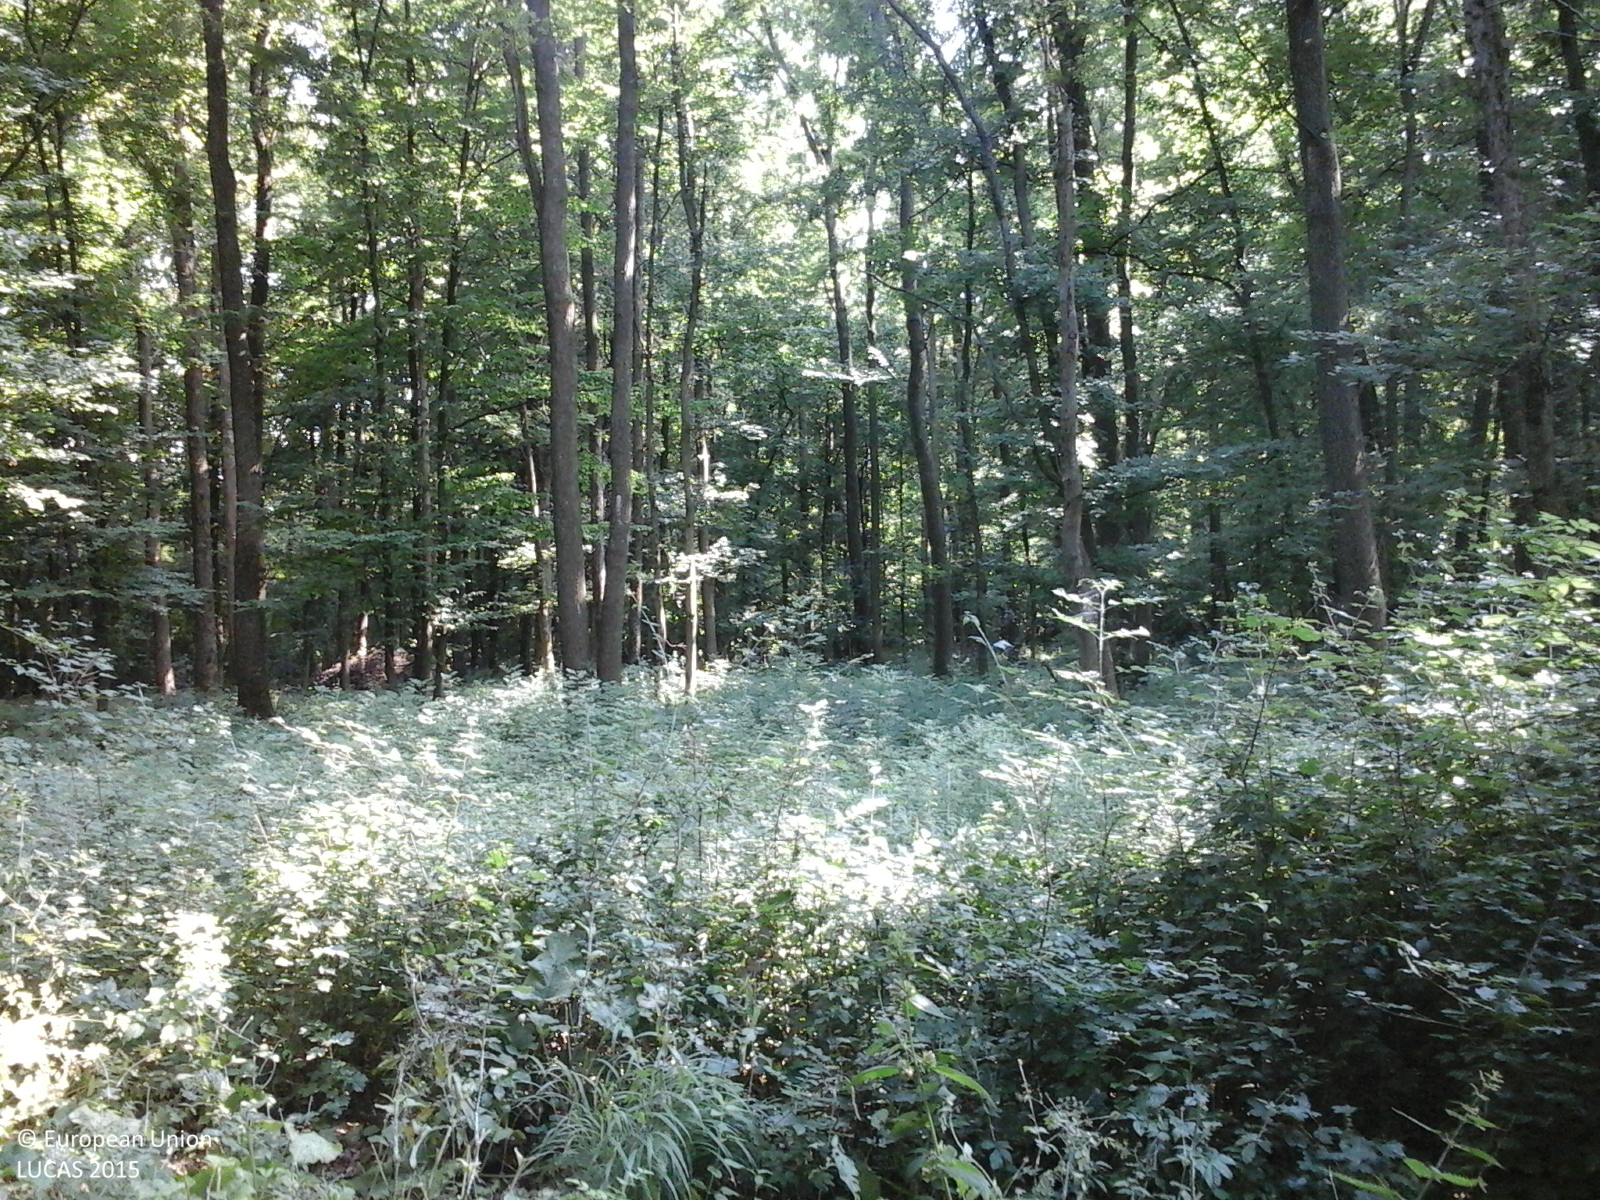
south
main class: Woodland
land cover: Broadleaved woodland
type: mesophytic deciduous forest
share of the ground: > 75 %
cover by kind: broadleaved forest trees 85 %, herbaceous plants 10 %, shrubs 5 %
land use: Forestry
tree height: > 5 m
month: June
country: RO
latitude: 44.5300
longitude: 26.1254
